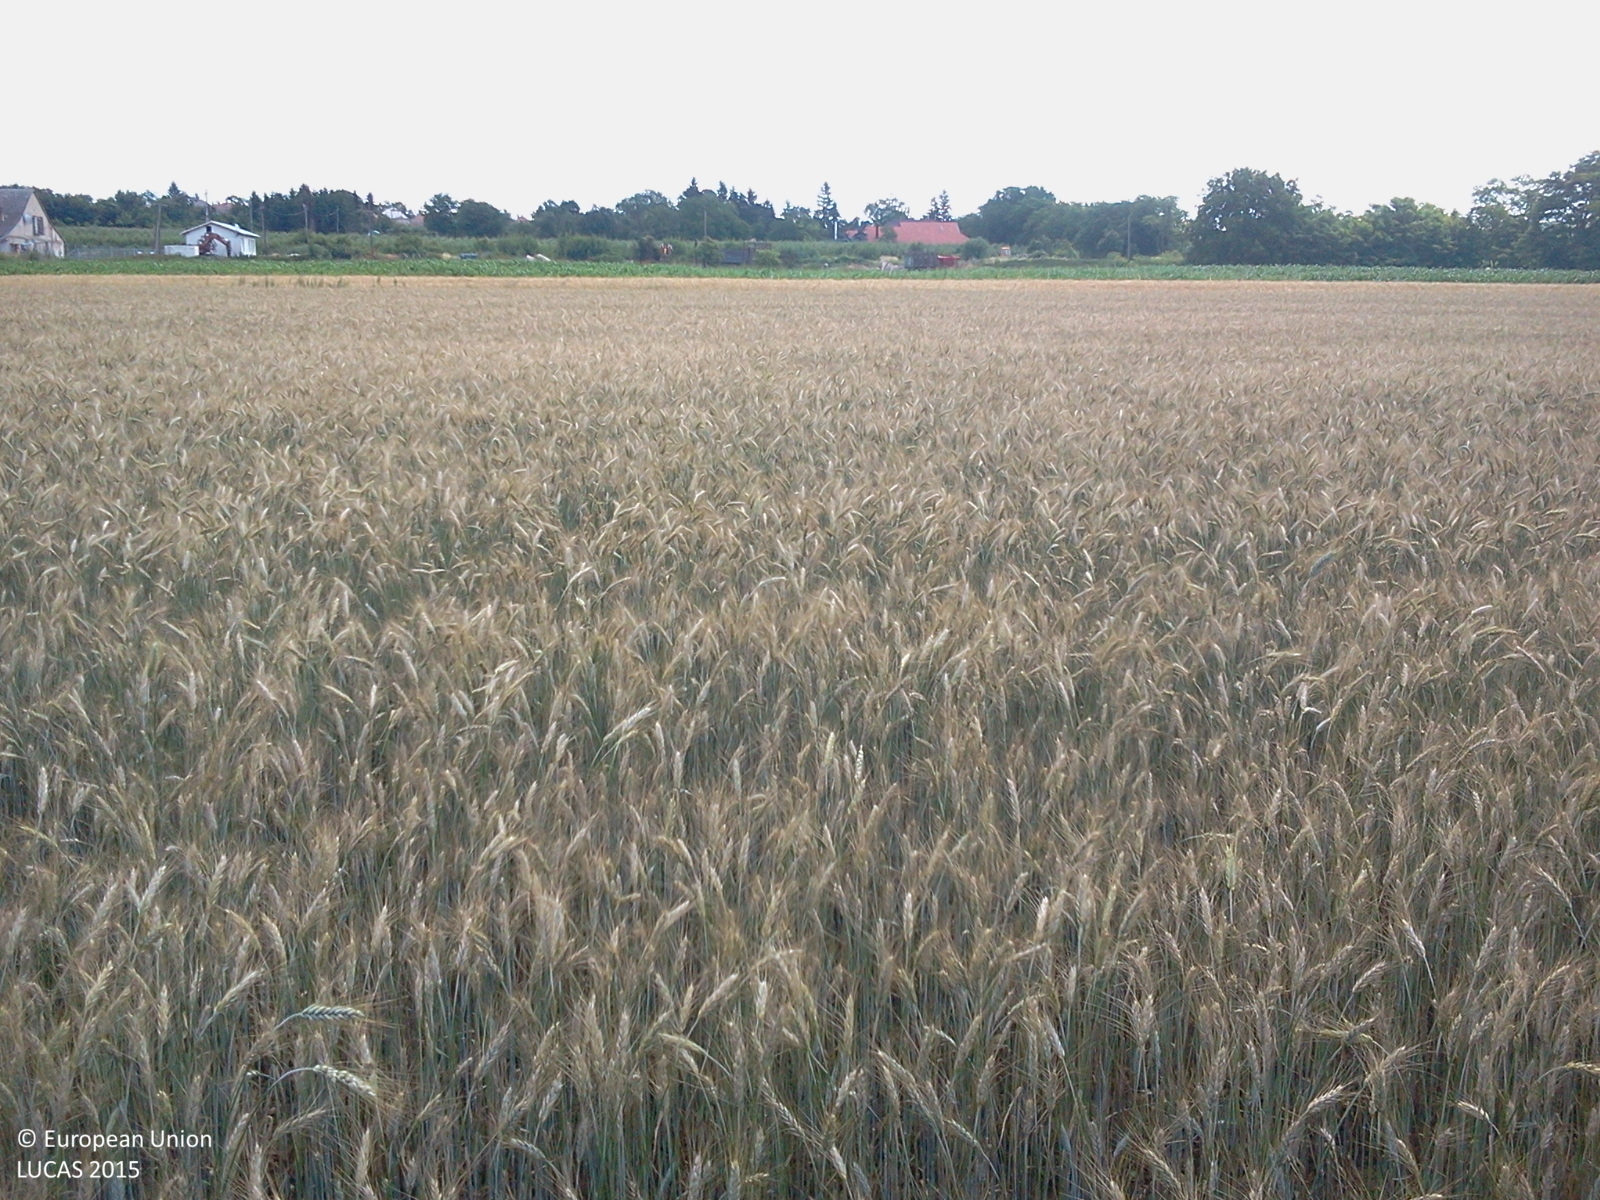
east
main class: Cropland
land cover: Durum wheat
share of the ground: > 75 %
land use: Agriculture (excluding fallow land and kitchen gardens)
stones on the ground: < 10 %
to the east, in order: Durum wheat; Barley; Maize; Durum wheat; Grass margins; Ditches and canals; Grassland without tree/shrub cover; Paved roads, cycling and walking lanes; Grass margins; Ditches and canals; Shrubland with sparse tree cover
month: June
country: HU
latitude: 46.9637
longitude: 17.1147
